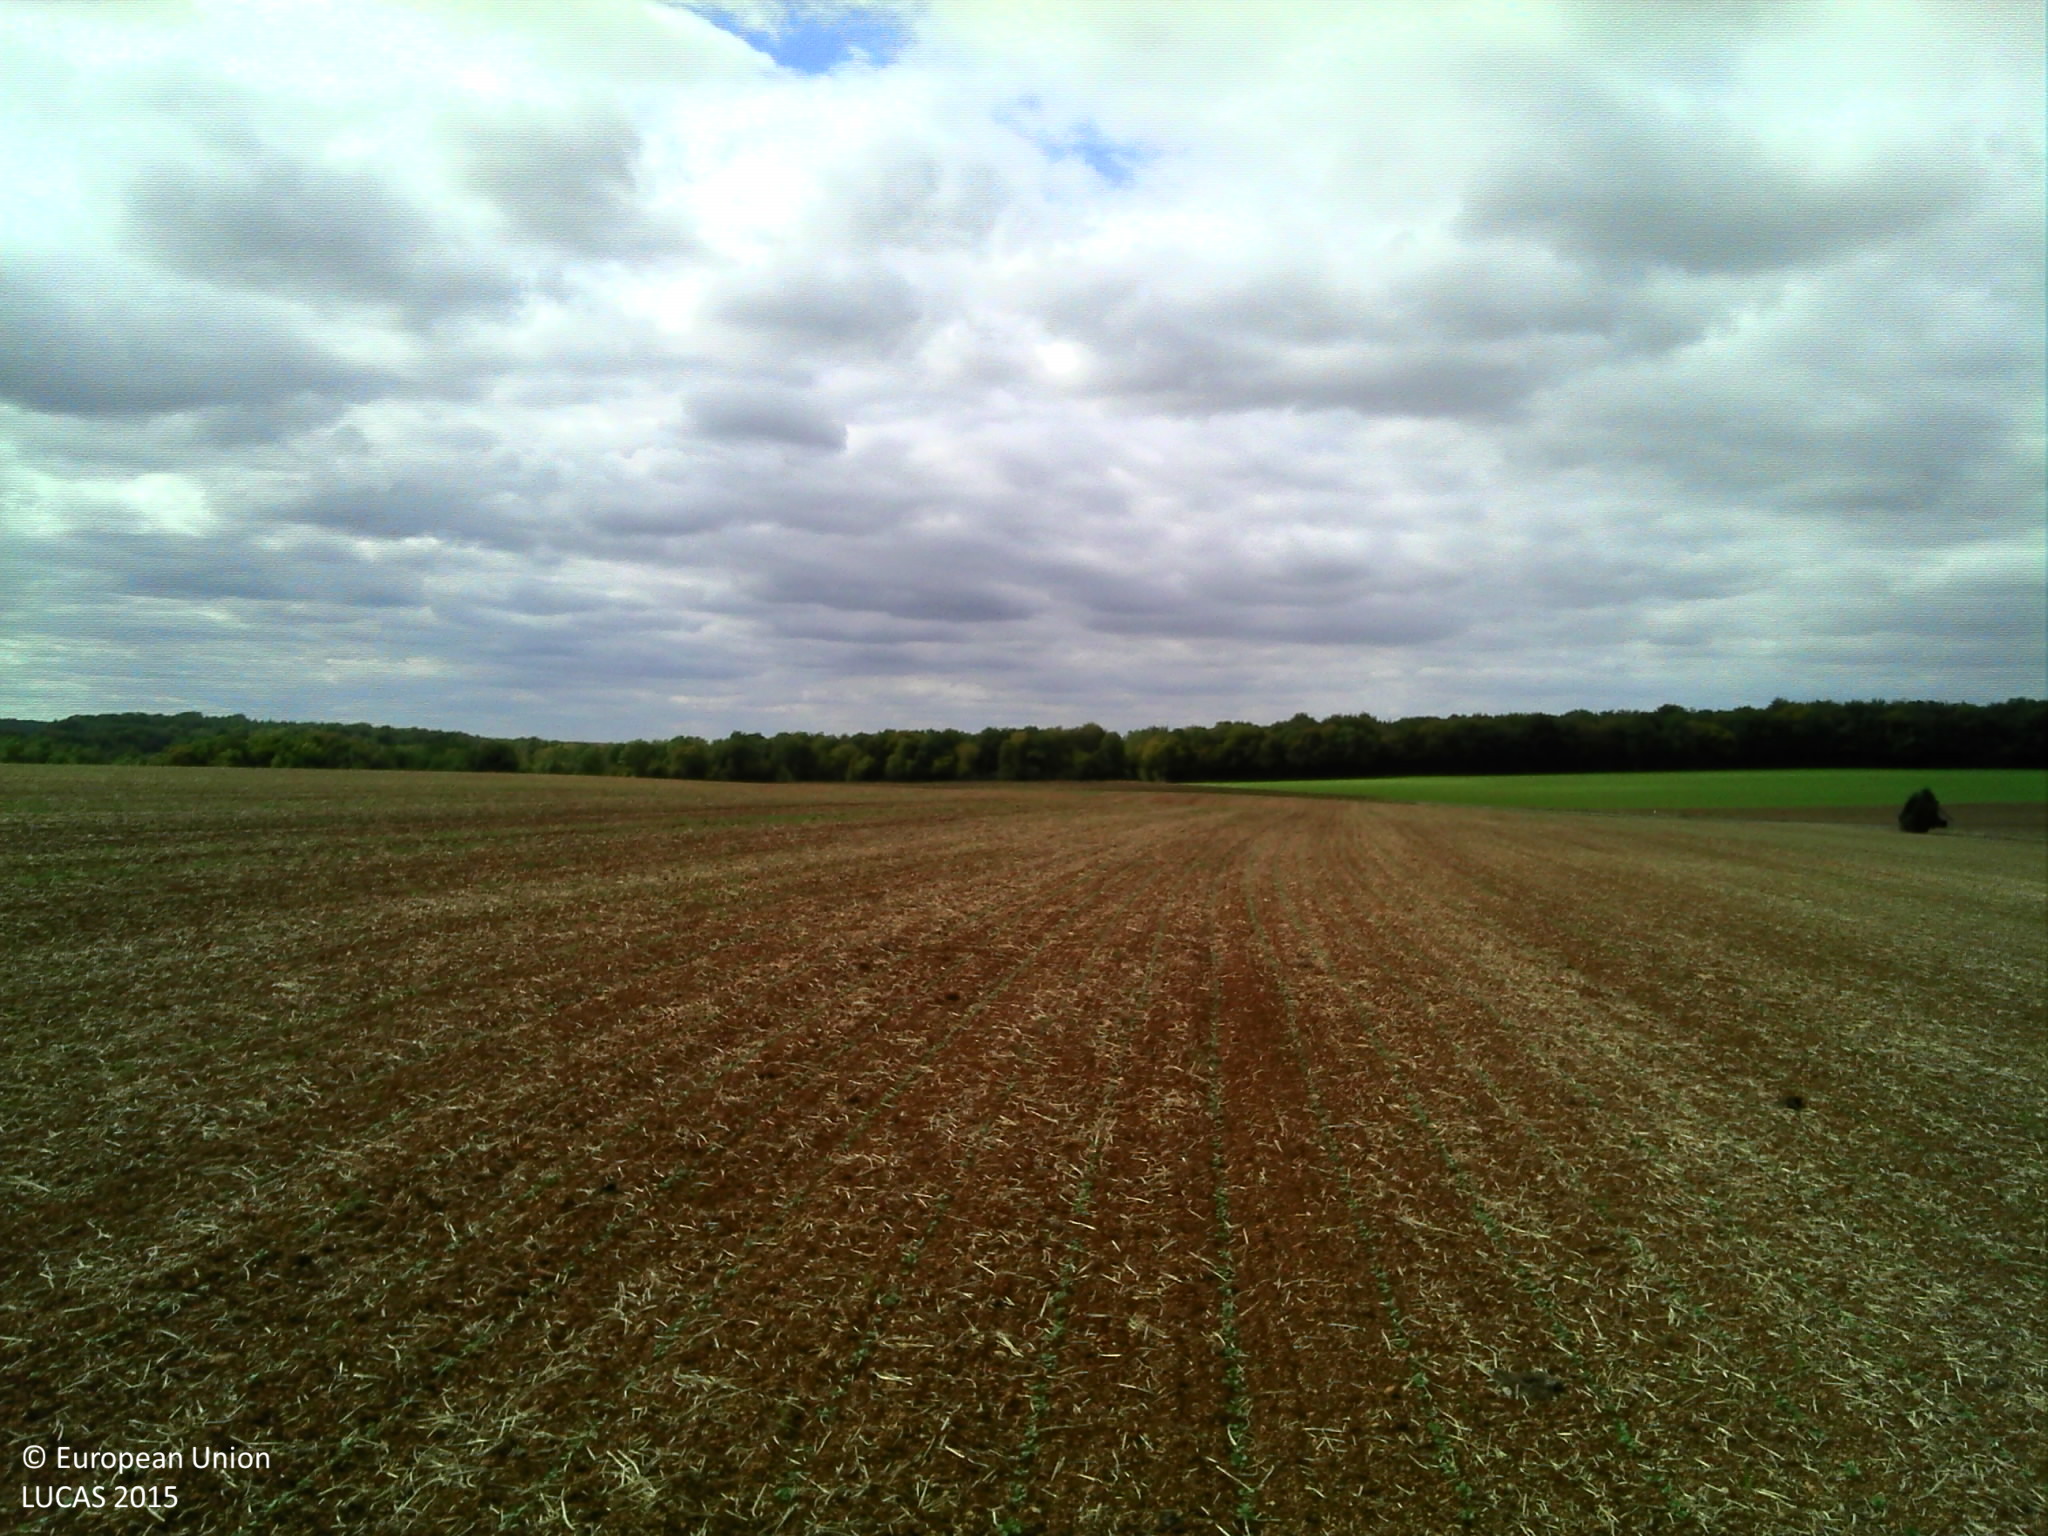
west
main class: Cropland
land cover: Barley
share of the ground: 10 - 25 %
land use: Agriculture (excluding fallow land and kitchen gardens)
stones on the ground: 10 - 25 %
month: September
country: FR
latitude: 47.5382
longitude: 4.7254
